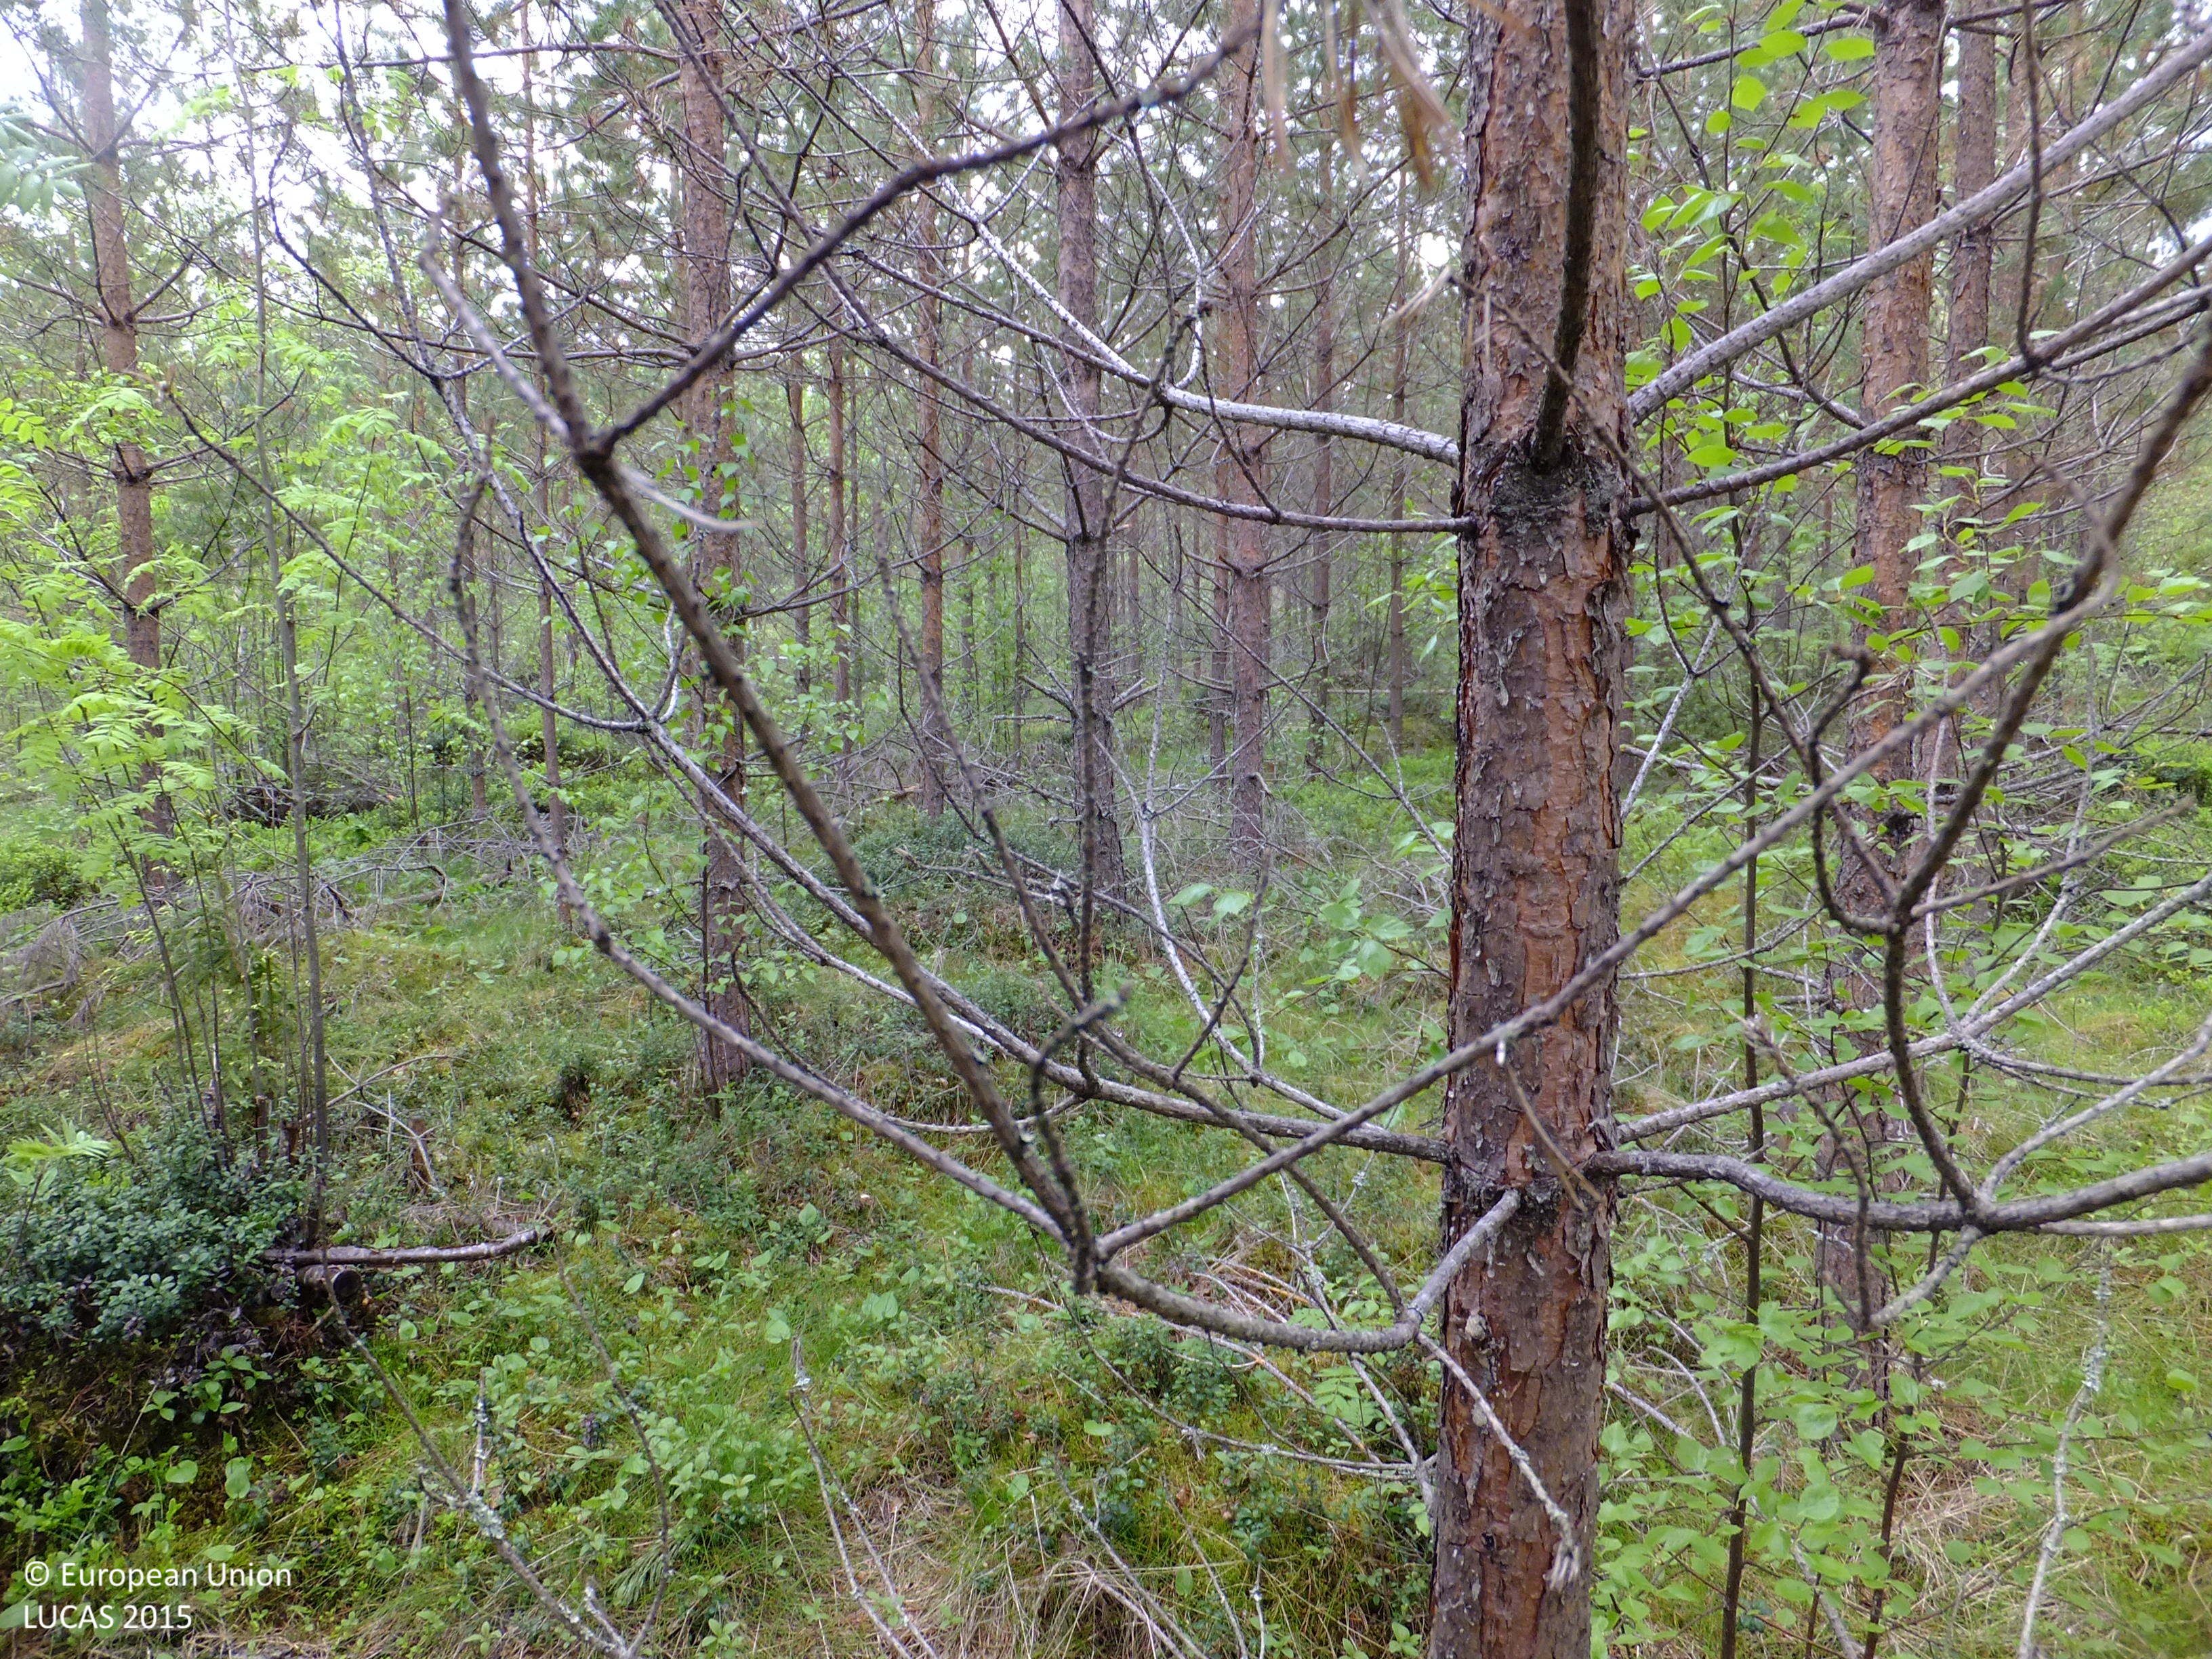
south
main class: Woodland
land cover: Pine dominated mixed woodland
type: boreal forest
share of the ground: > 75 %
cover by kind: coniferous forest trees 55 %, broadleaved forest trees 20 %, herbaceous plants 15 %, shrubs 10 %
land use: Forestry
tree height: < 5 m
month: June
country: FI
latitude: 63.4621
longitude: 23.1569
